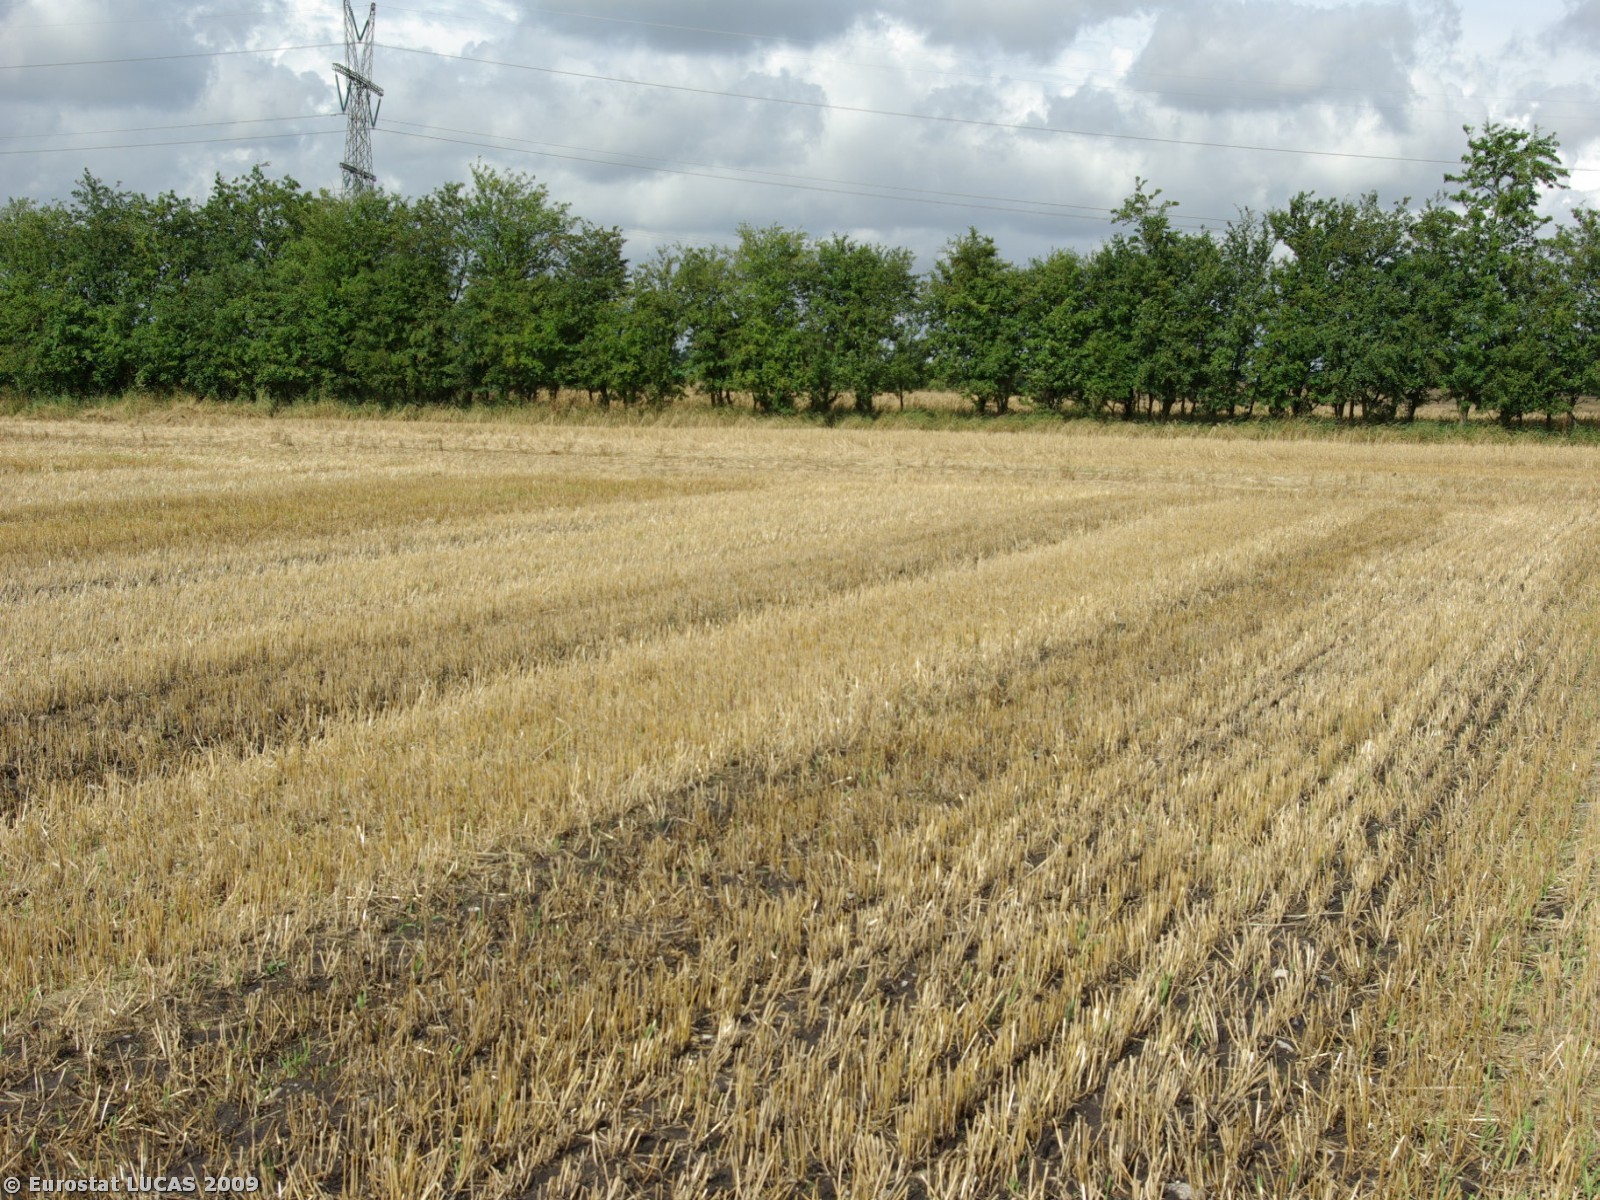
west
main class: Cropland
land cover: Barley
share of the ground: < 10 %
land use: Agriculture (excluding fallow land and kitchen gardens)
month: July
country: DK
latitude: 55.1433
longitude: 9.2946
